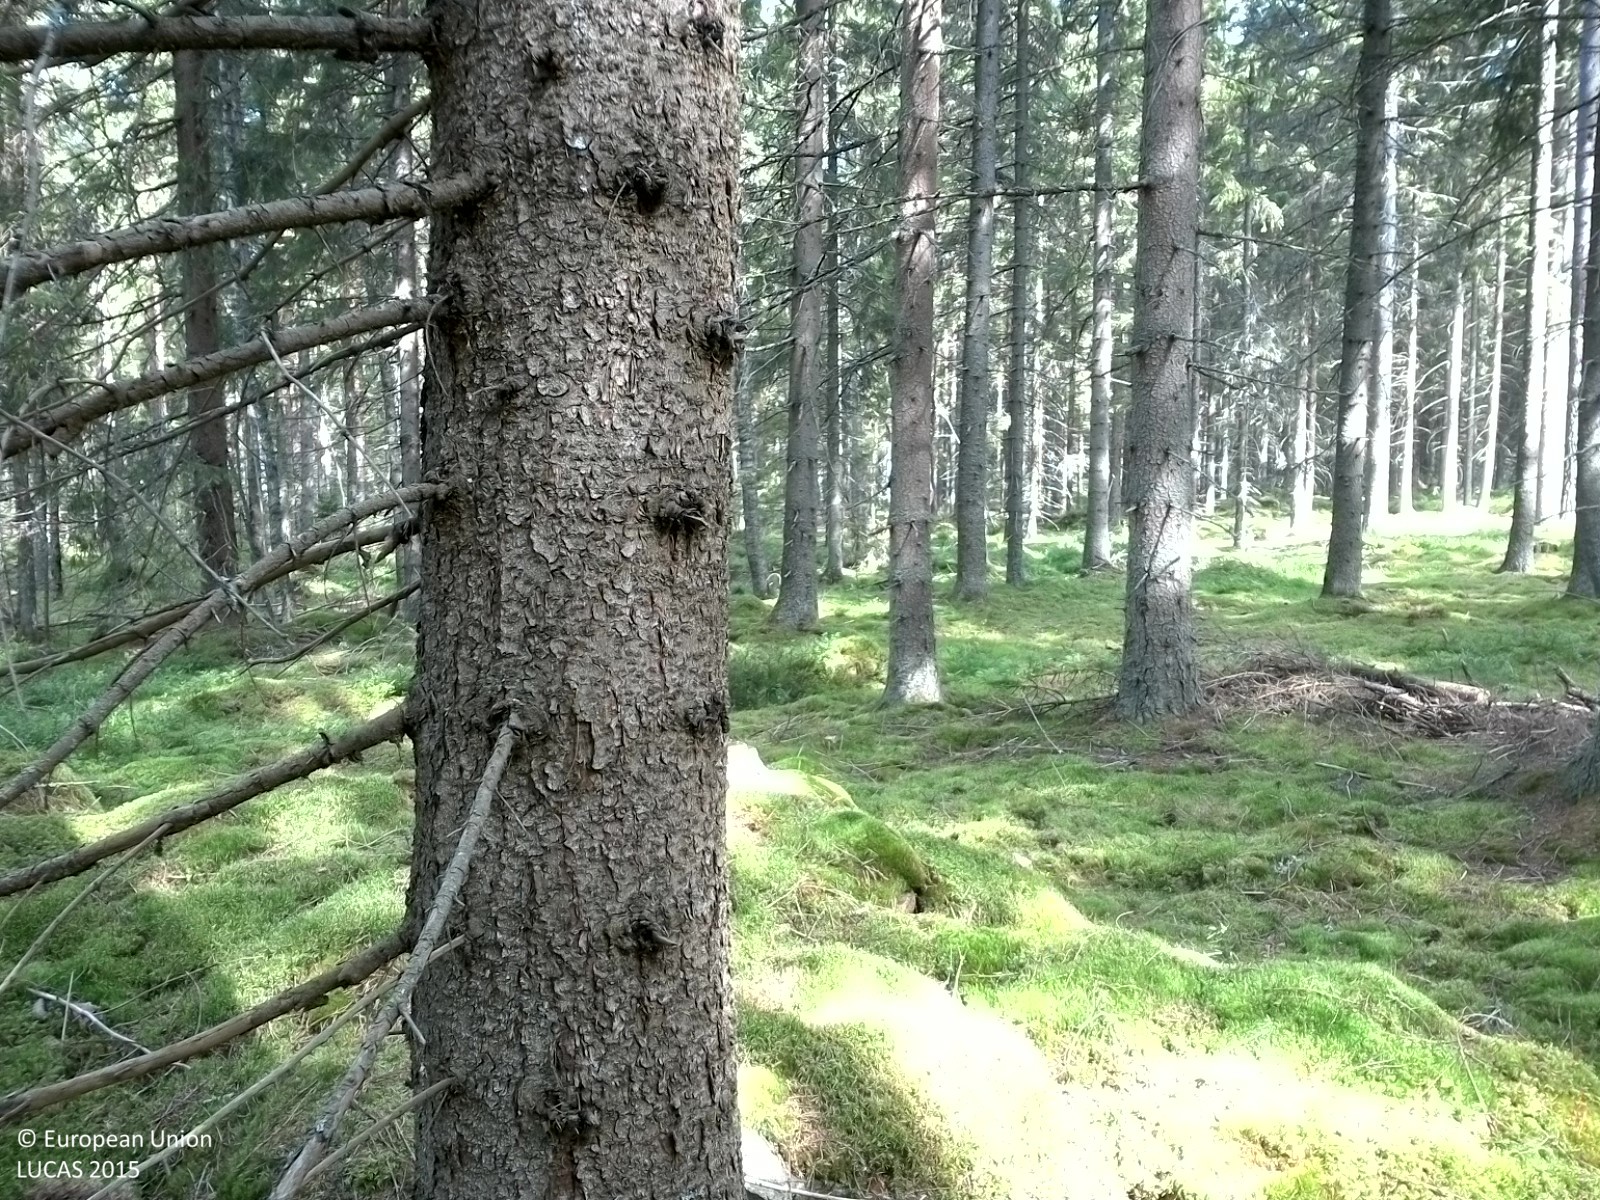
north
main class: Woodland
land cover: Spruce dominated coniferous woodland
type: boreal forest
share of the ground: 50 - 75 %
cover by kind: coniferous forest trees 60 %, lichens and mosses 30 %, herbaceous plants 10 %
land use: Forestry
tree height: > 5 m
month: August
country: SE
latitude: 59.0536
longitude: 14.7866
